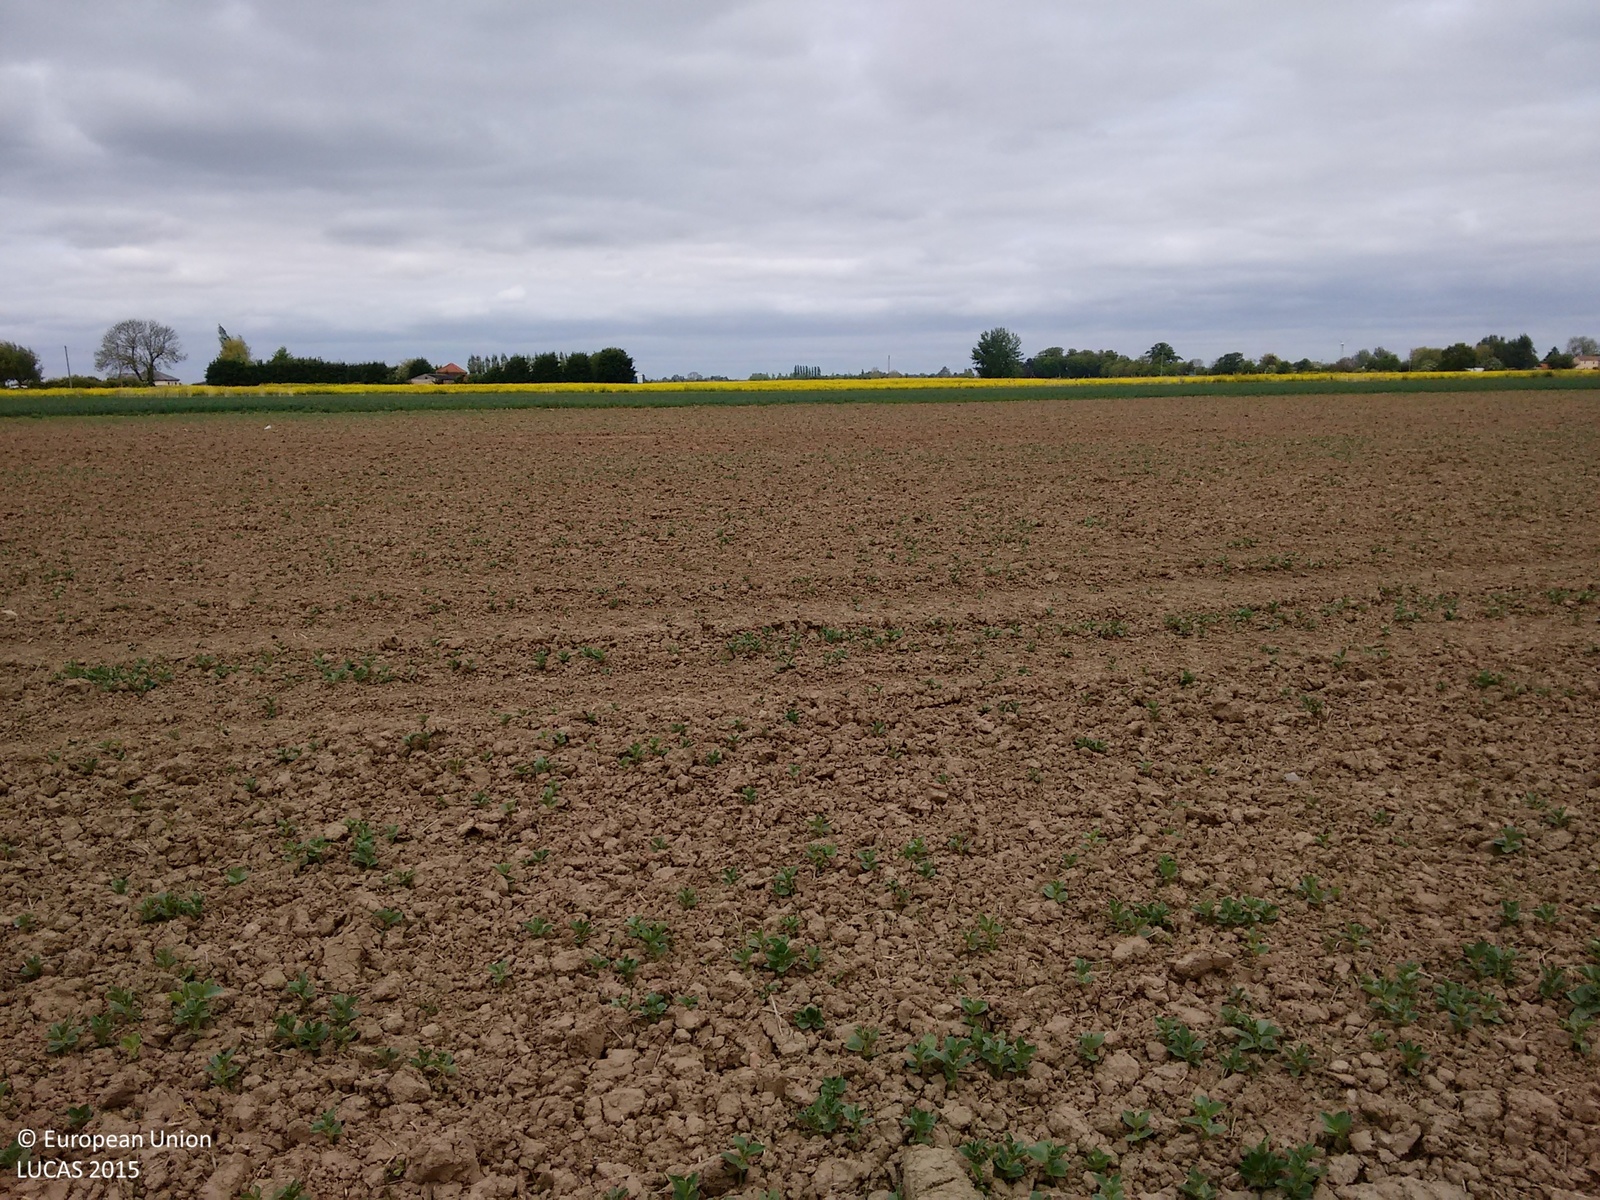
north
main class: Cropland
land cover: Dry pulses
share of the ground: 10 - 25 %
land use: Agriculture (excluding fallow land and kitchen gardens)
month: May
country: GB
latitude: 52.7432
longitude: 0.1184
